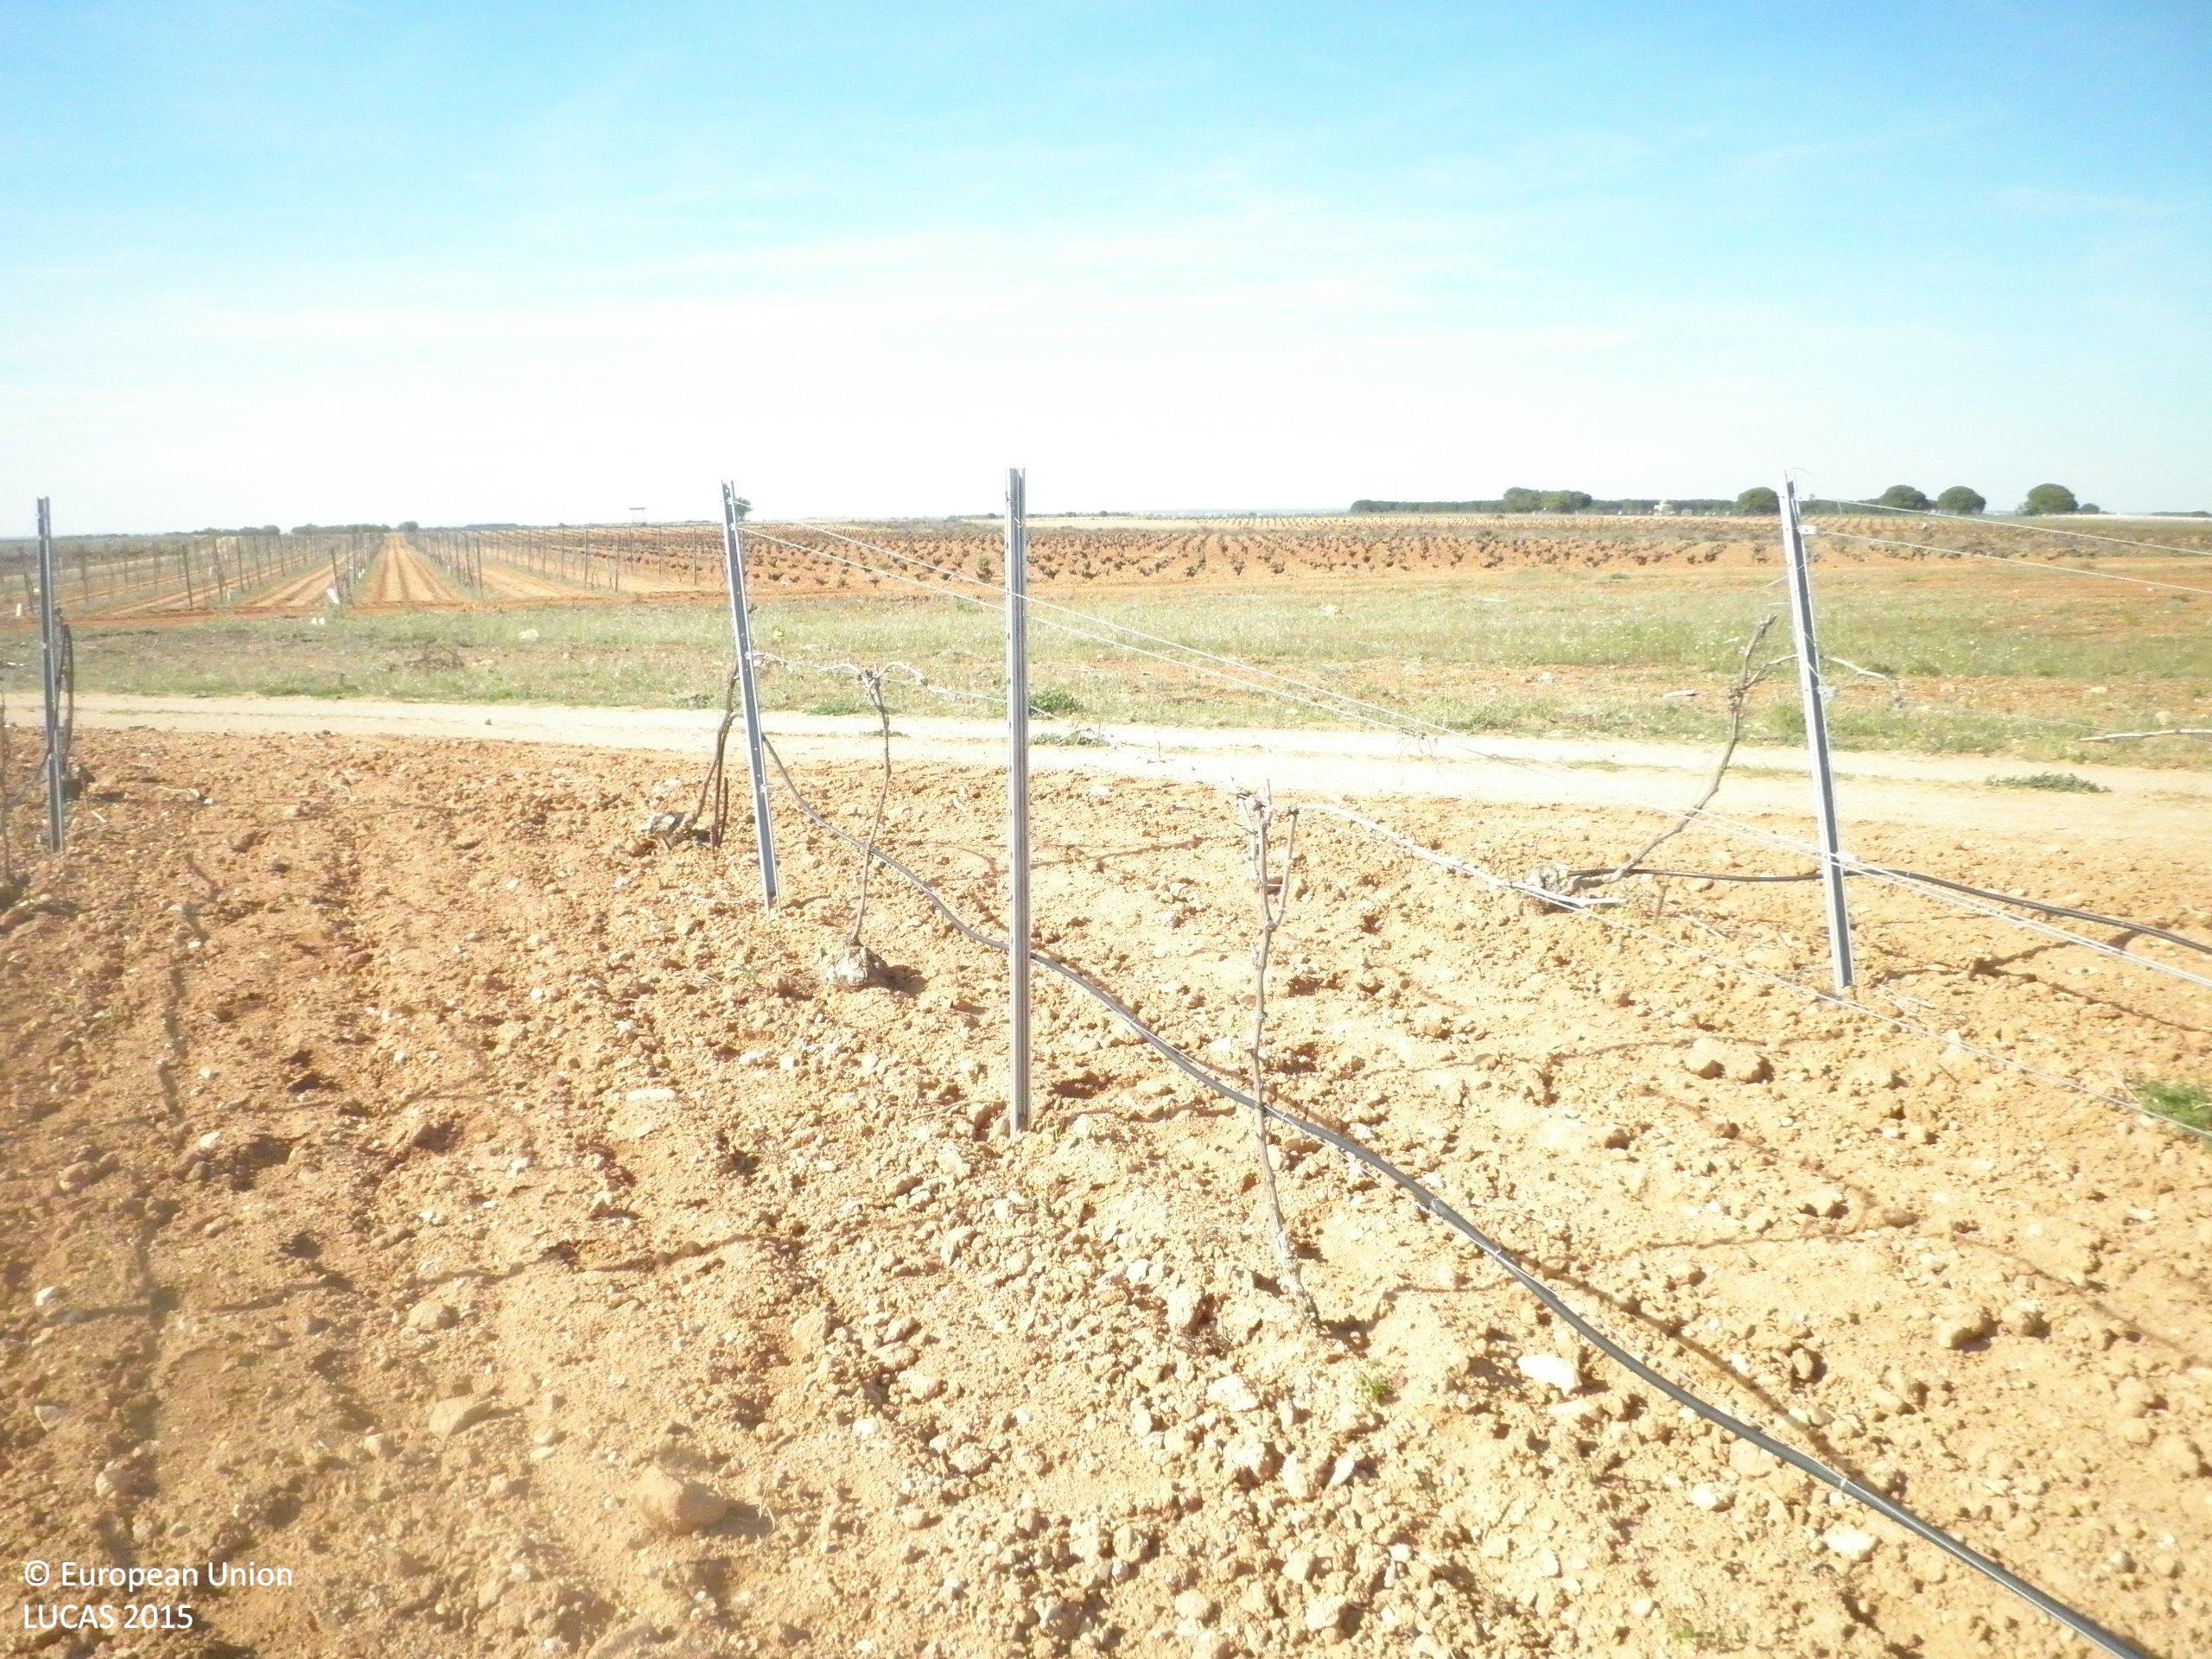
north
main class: Cropland
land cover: Vineyards
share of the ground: < 10 %
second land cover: Other bare soil
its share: > 75 %
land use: Agriculture (excluding fallow land and kitchen gardens)
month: April
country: ES
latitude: 39.3654
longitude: -2.6983
